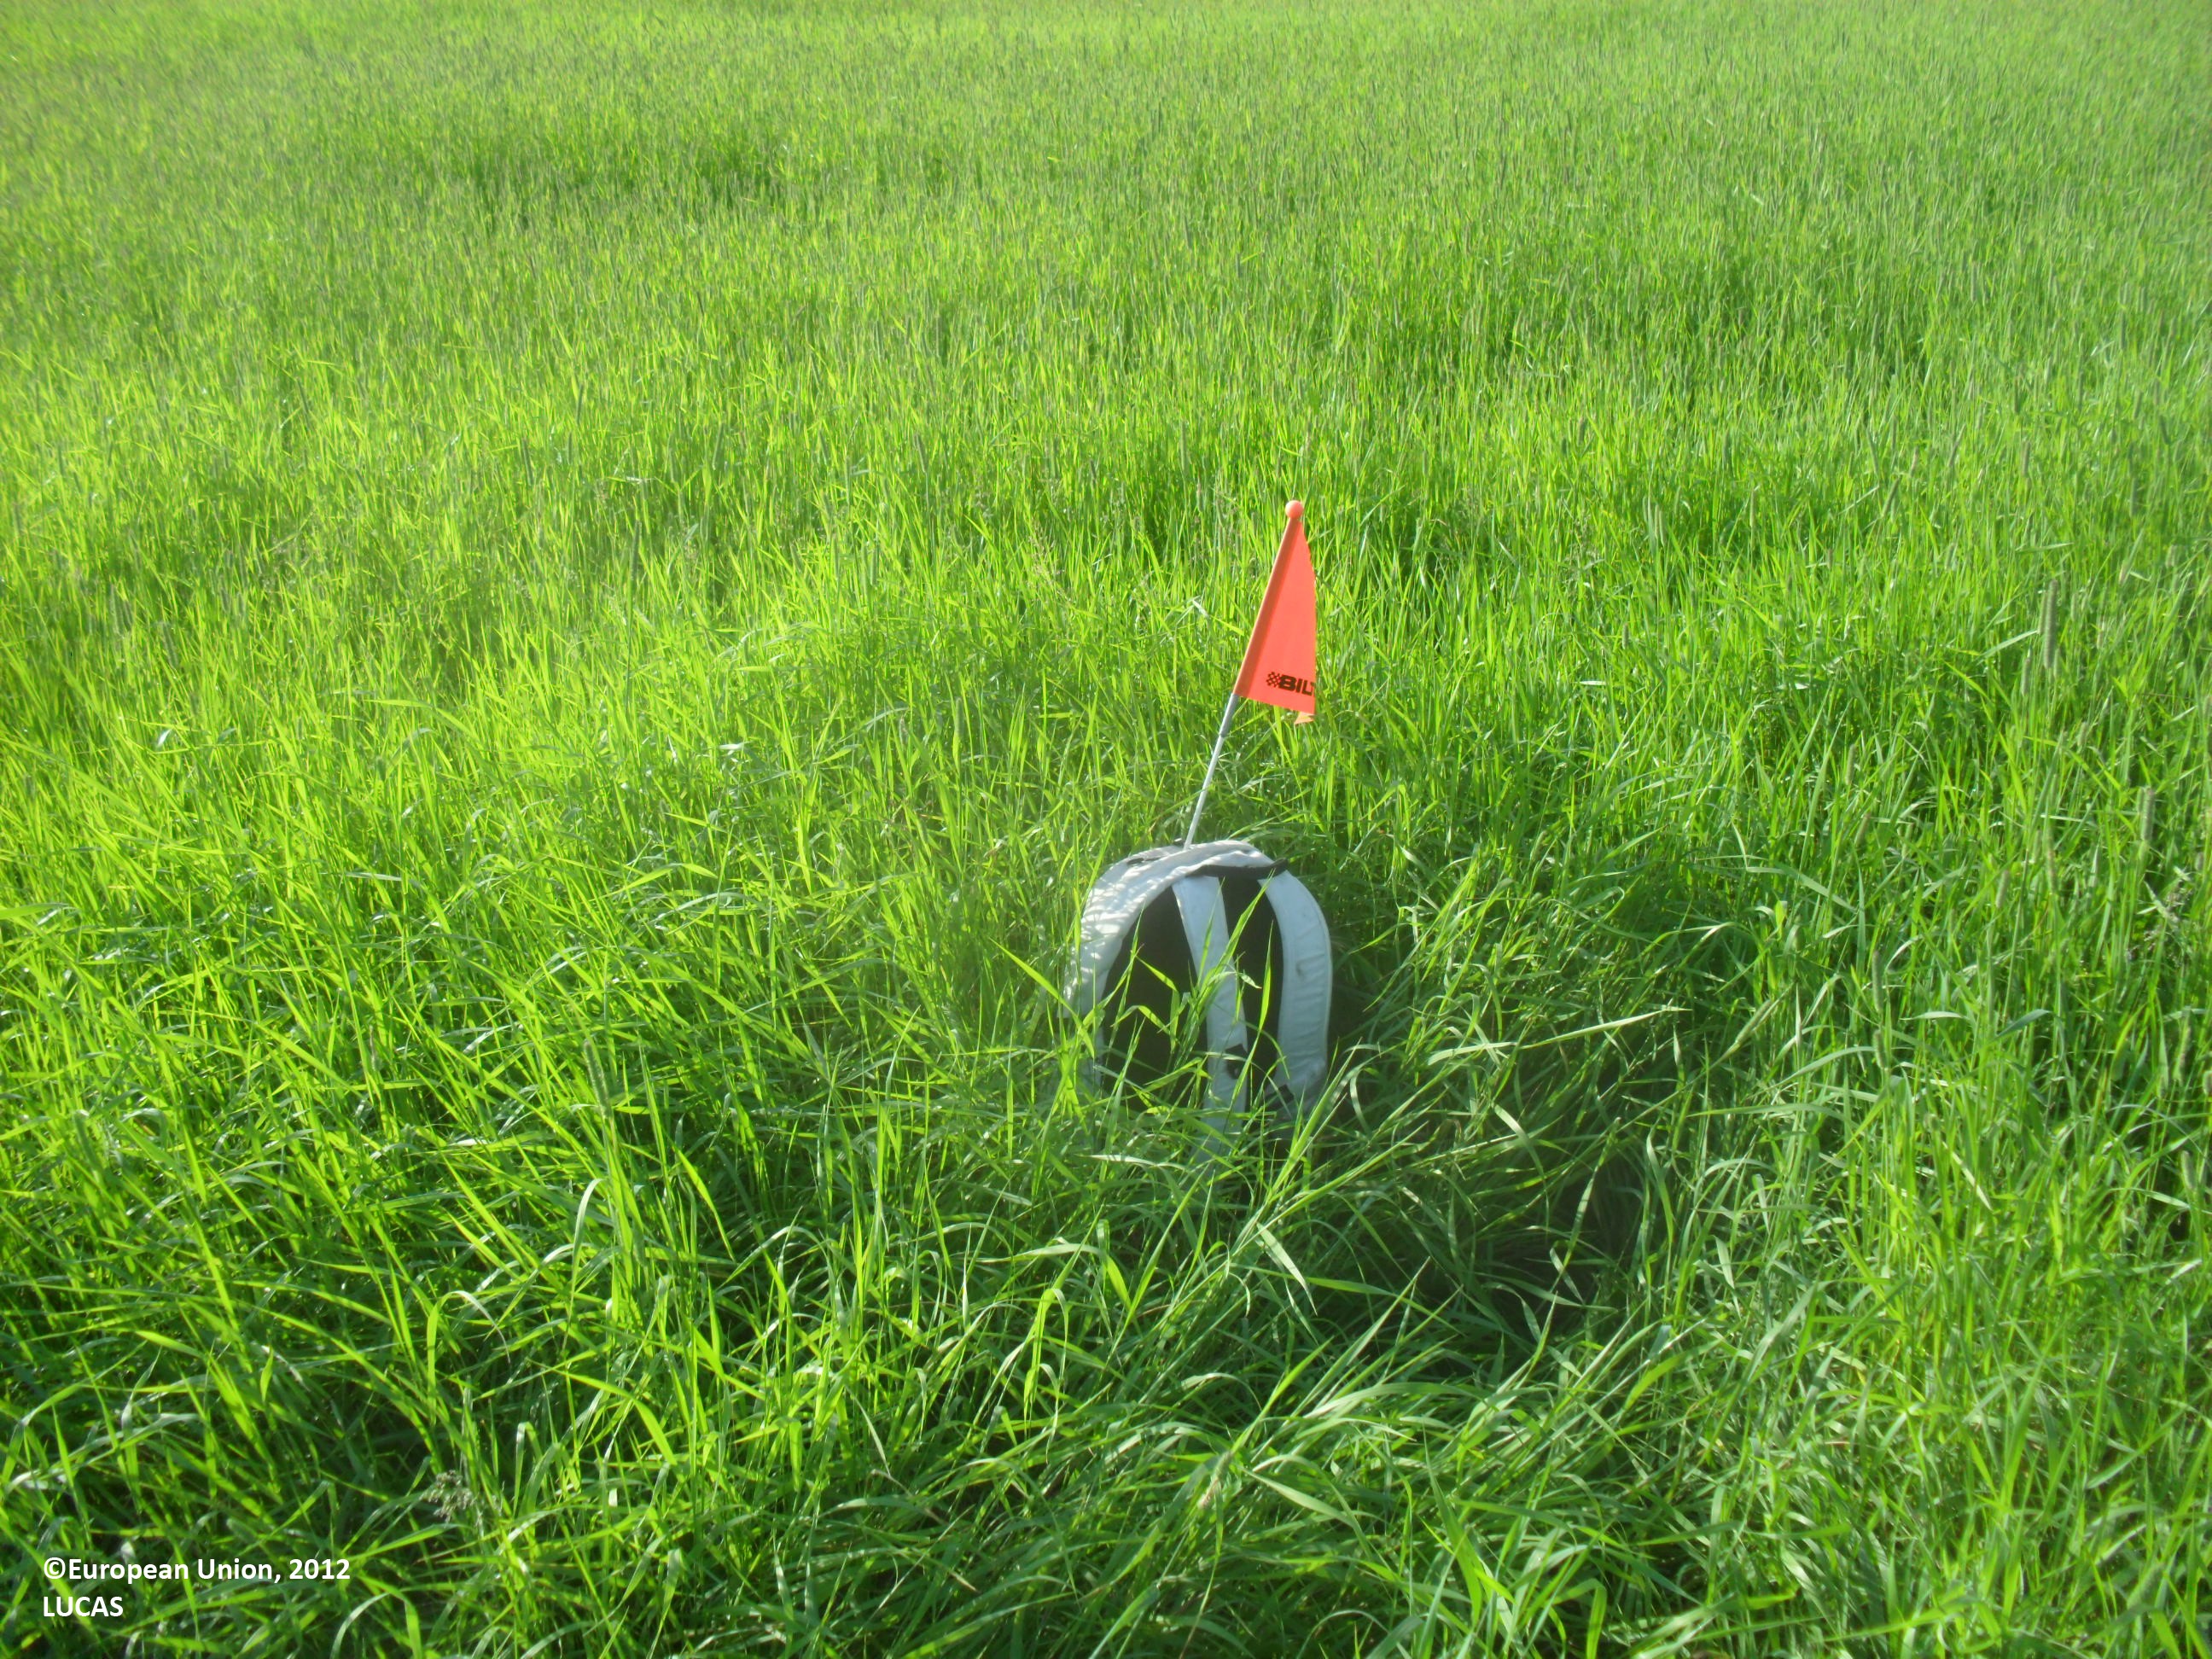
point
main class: Cropland
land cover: Temporary grasslands
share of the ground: > 75 %
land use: Agriculture (excluding fallow land and kitchen gardens)
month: July
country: FI
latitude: 63.5585
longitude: 23.7329
